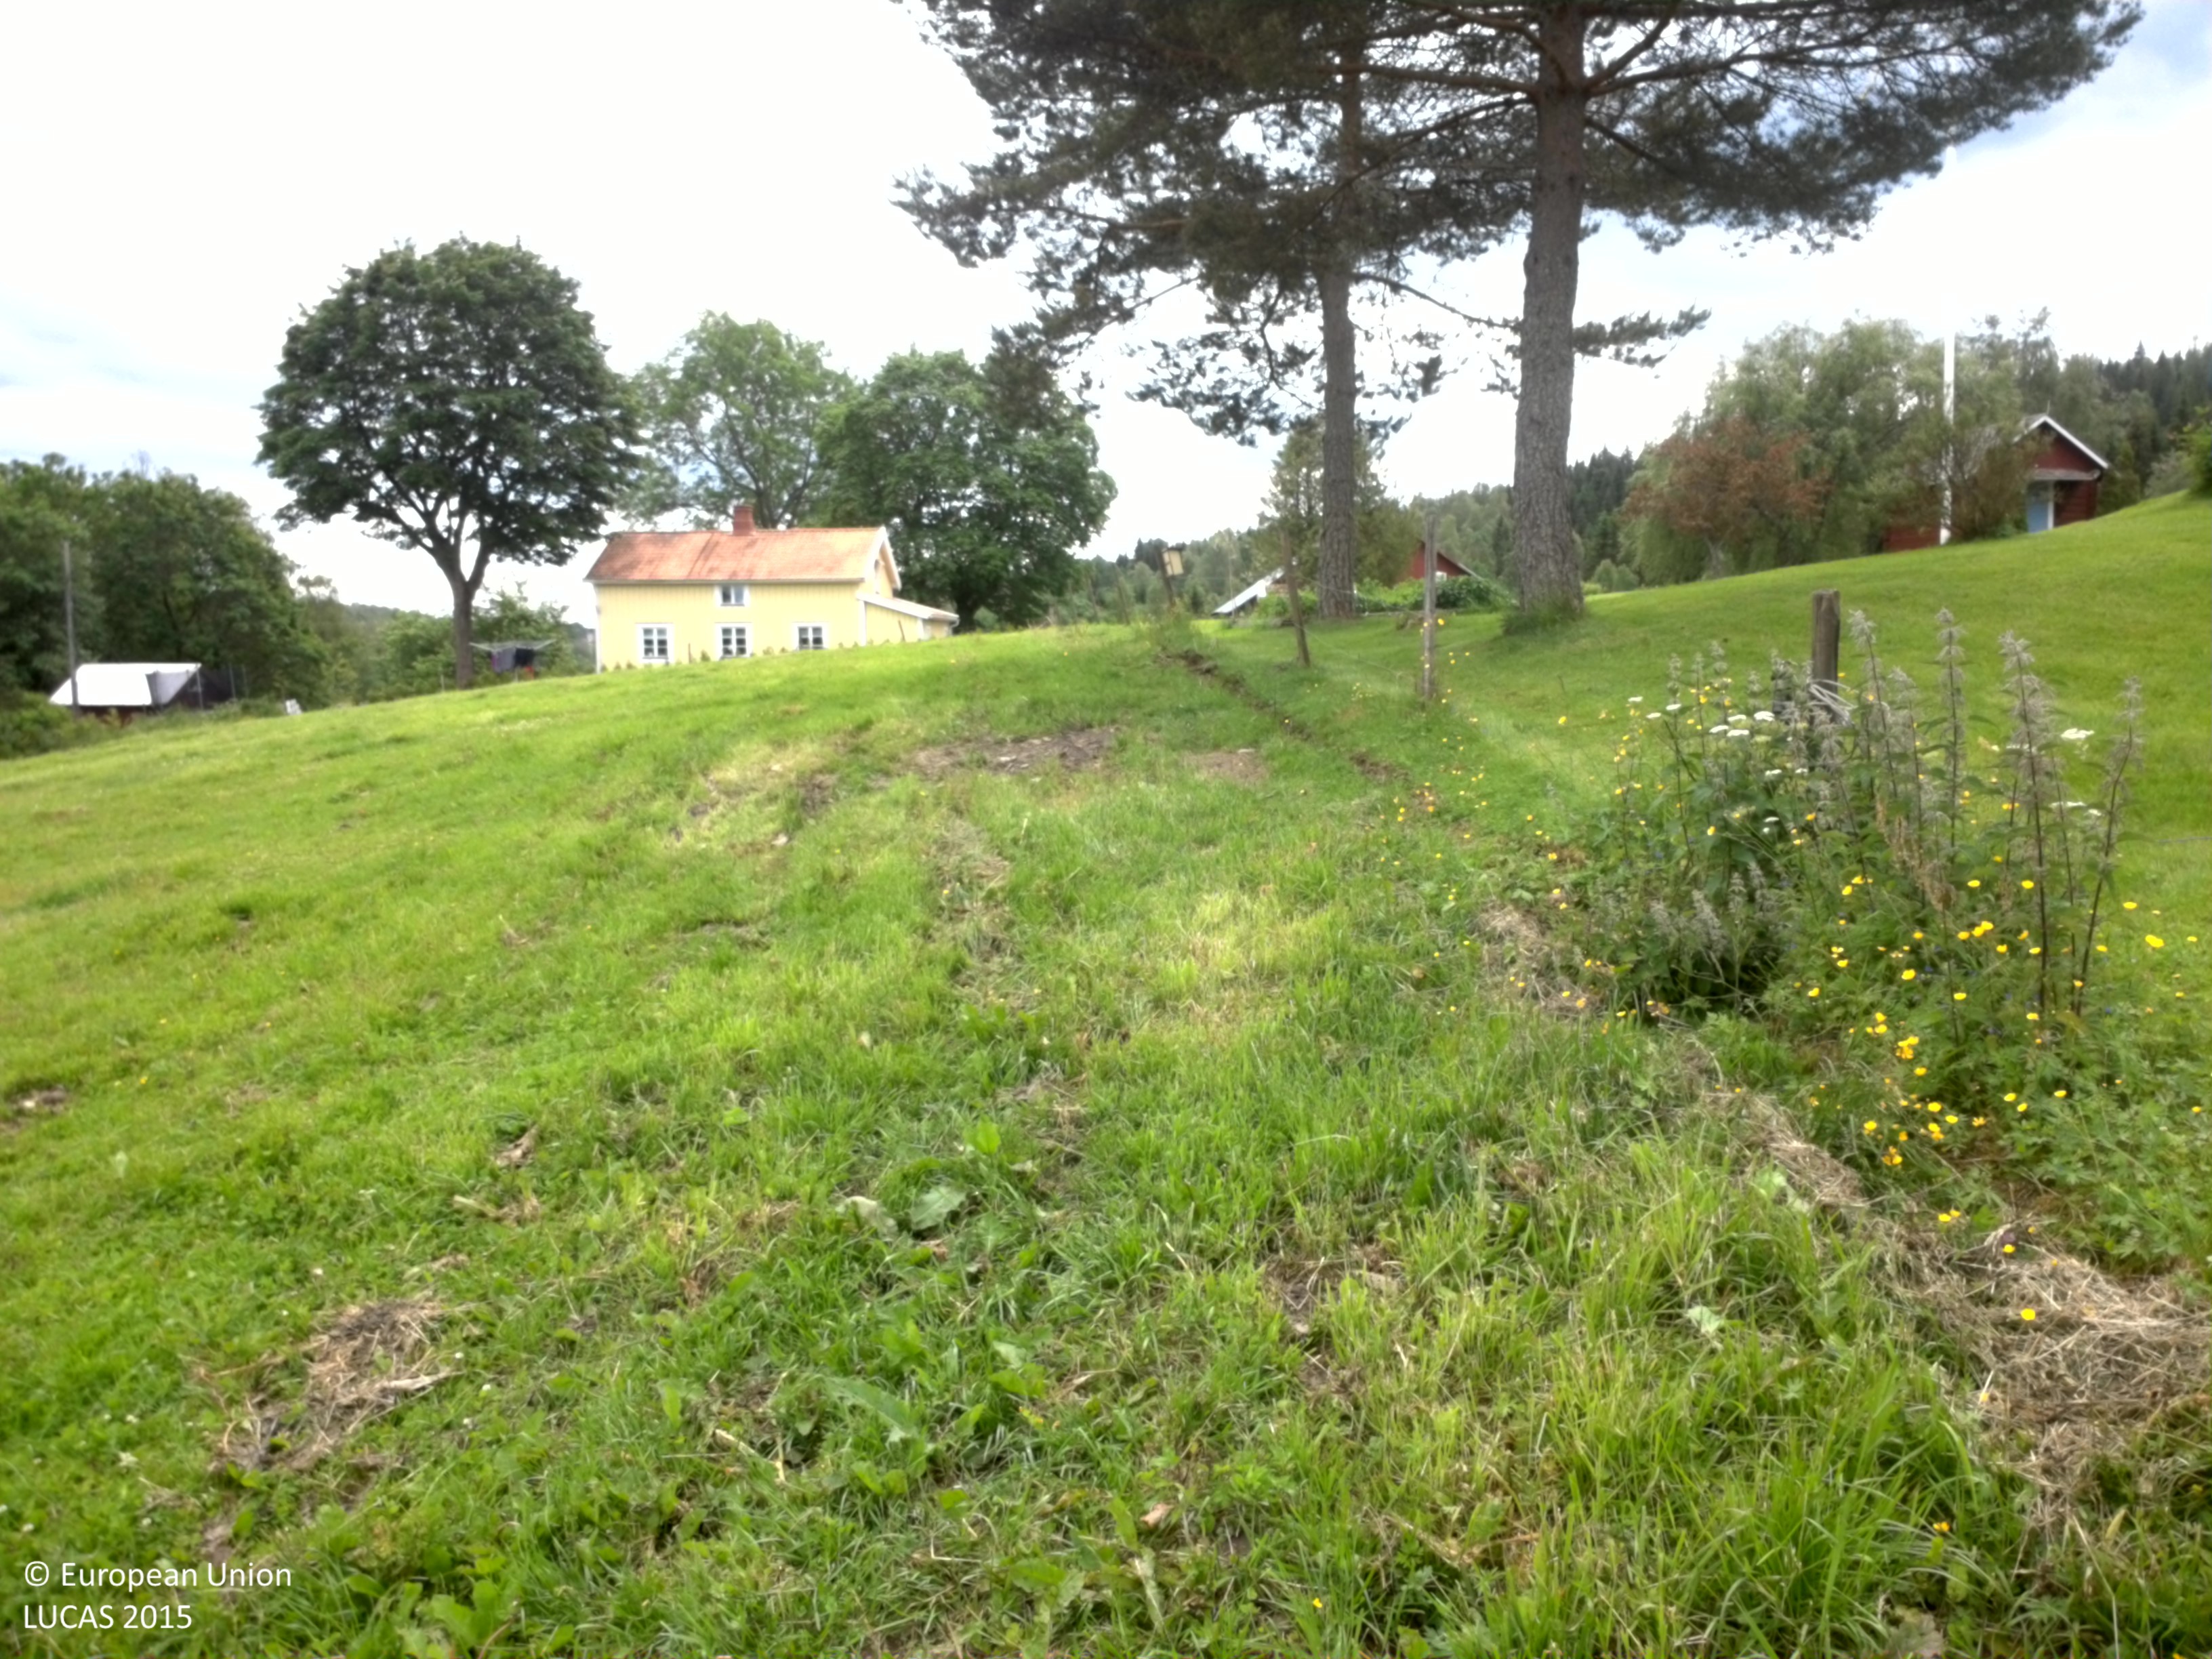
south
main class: Grassland
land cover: Grassland without tree/shrub cover
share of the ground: > 75 %
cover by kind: herbaceous plants 90 %, unconsolidated bare surface 10 %
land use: Agriculture (excluding fallow land and kitchen gardens)
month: June
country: SE
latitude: 59.7815
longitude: 12.4337
